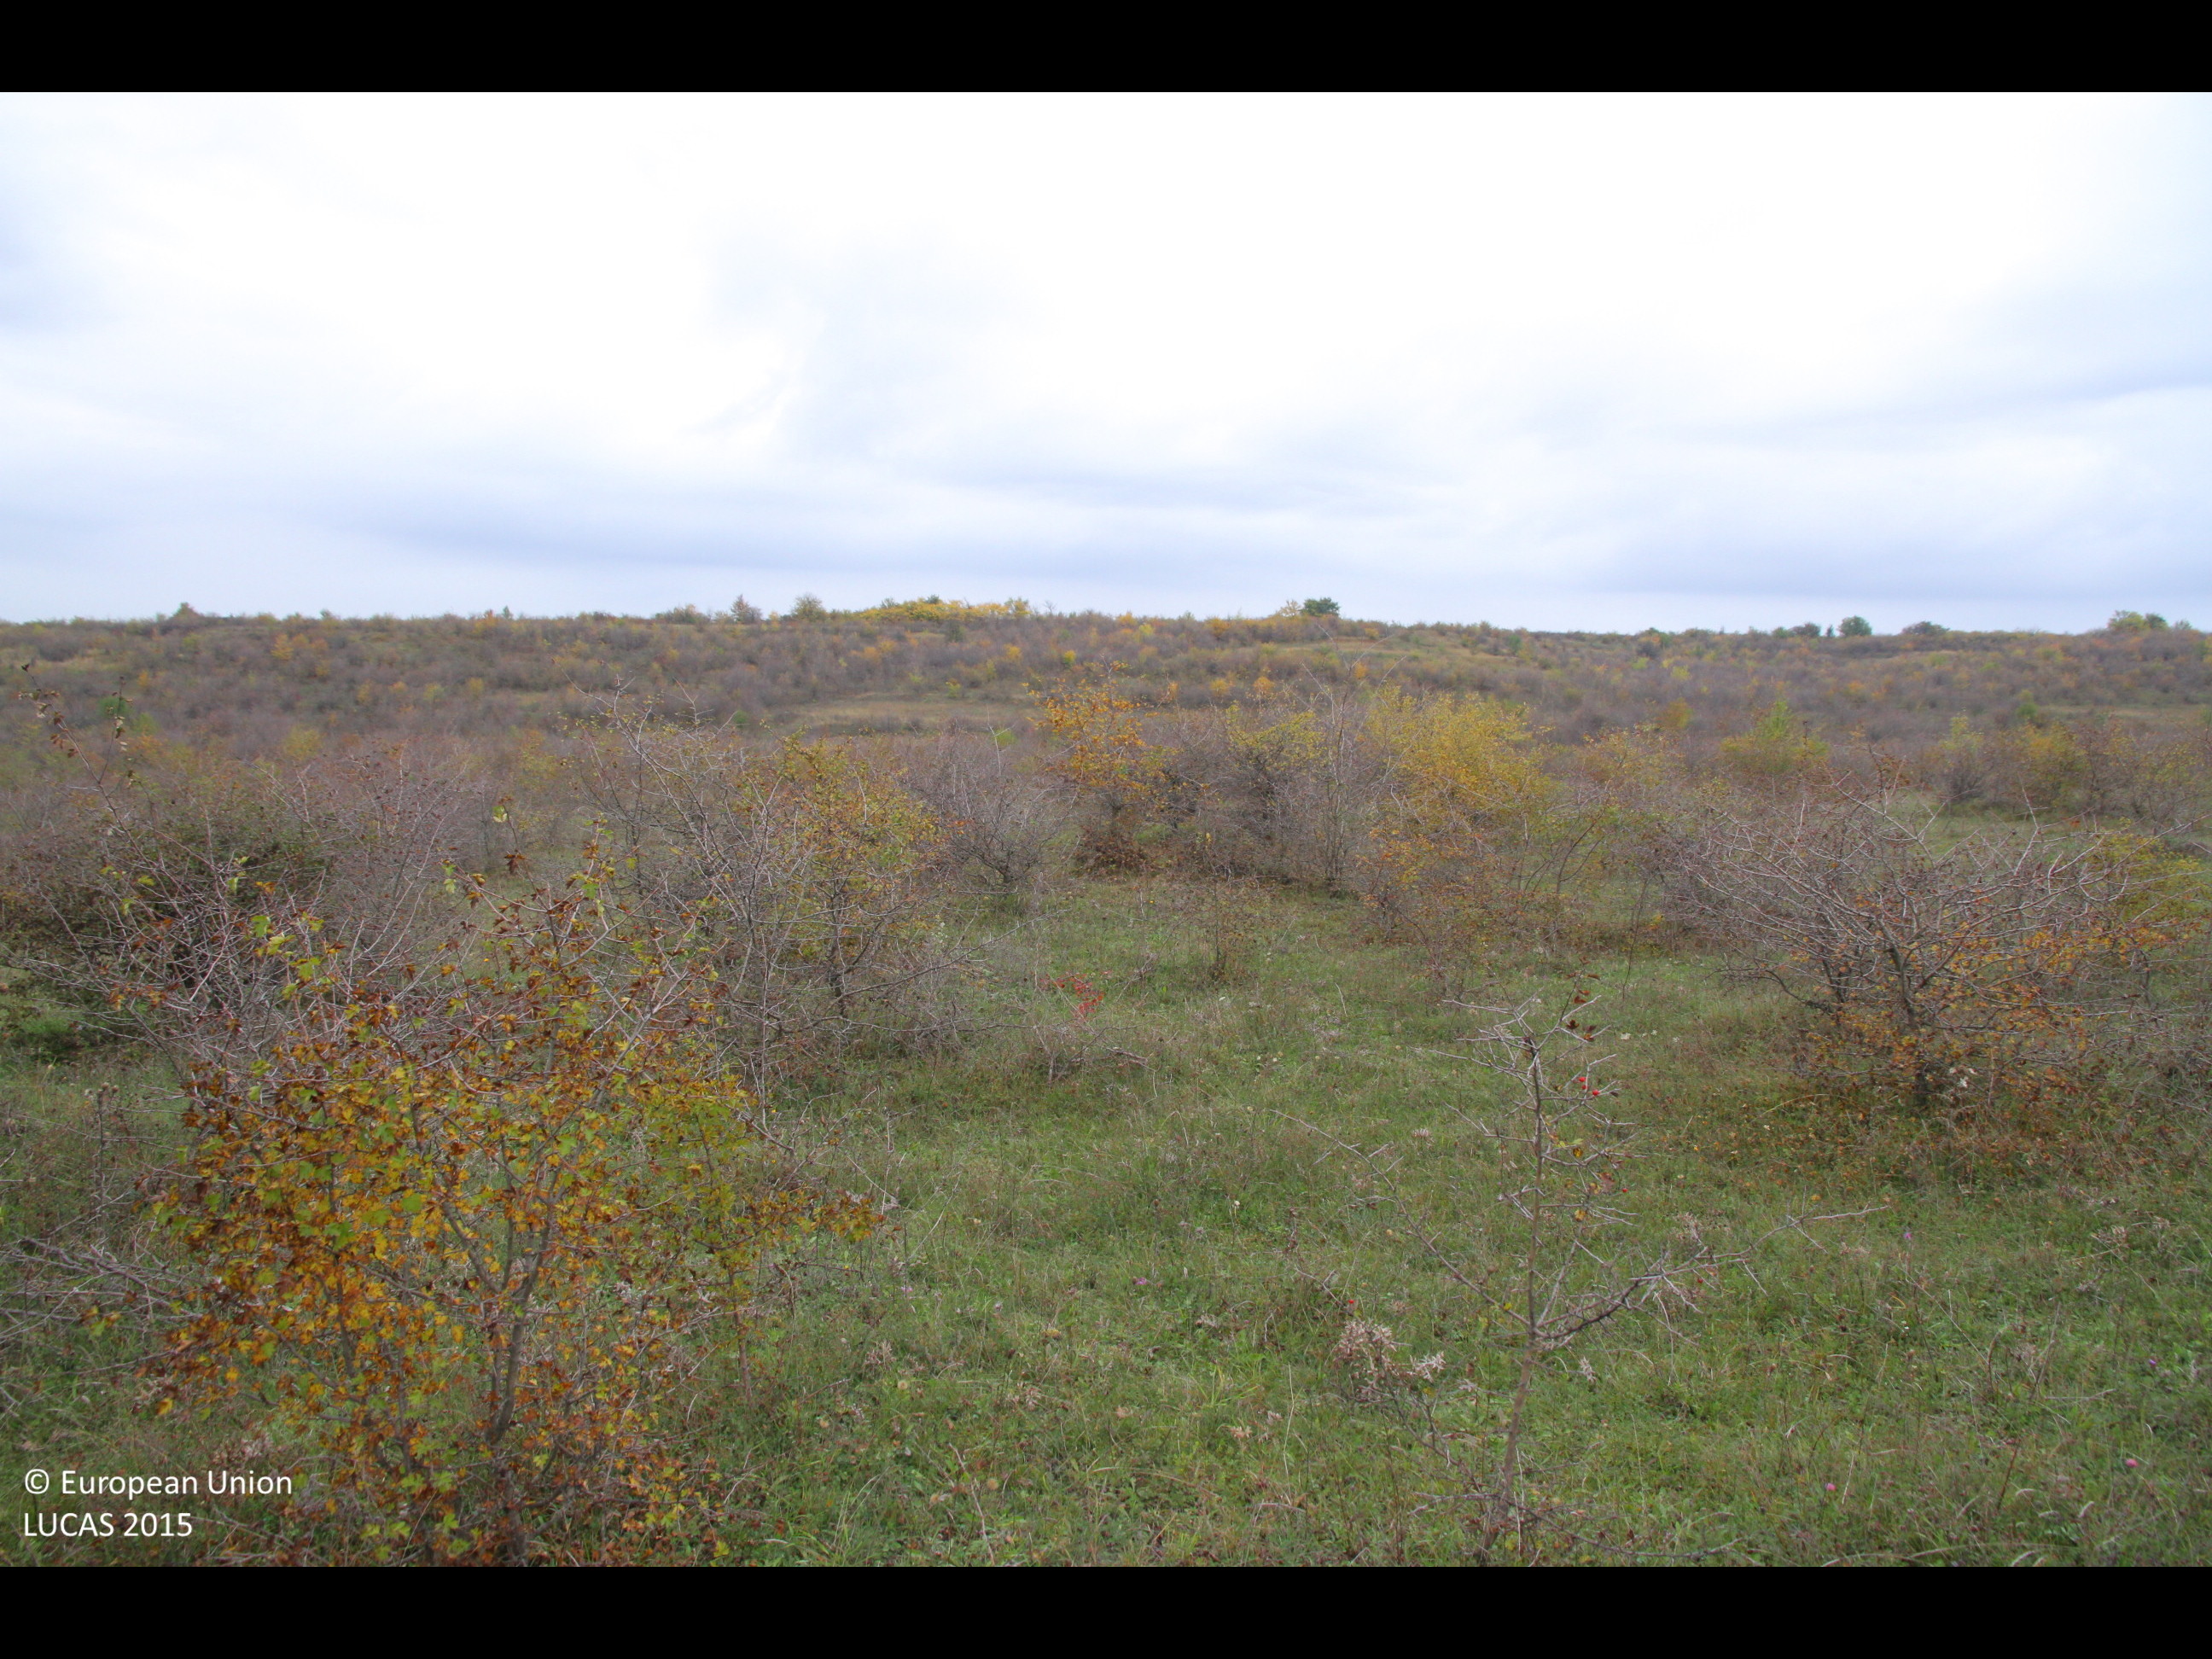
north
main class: Grassland
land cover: Grassland with sparse tree/shrub cover
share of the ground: > 75 %
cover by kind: herbaceous plants 85 %, shrubs 10 %, broadleaved forest trees 5 %
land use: Agriculture (excluding fallow land and kitchen gardens)
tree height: < 5 m
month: October
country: BG
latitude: 43.4207
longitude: 26.8485
